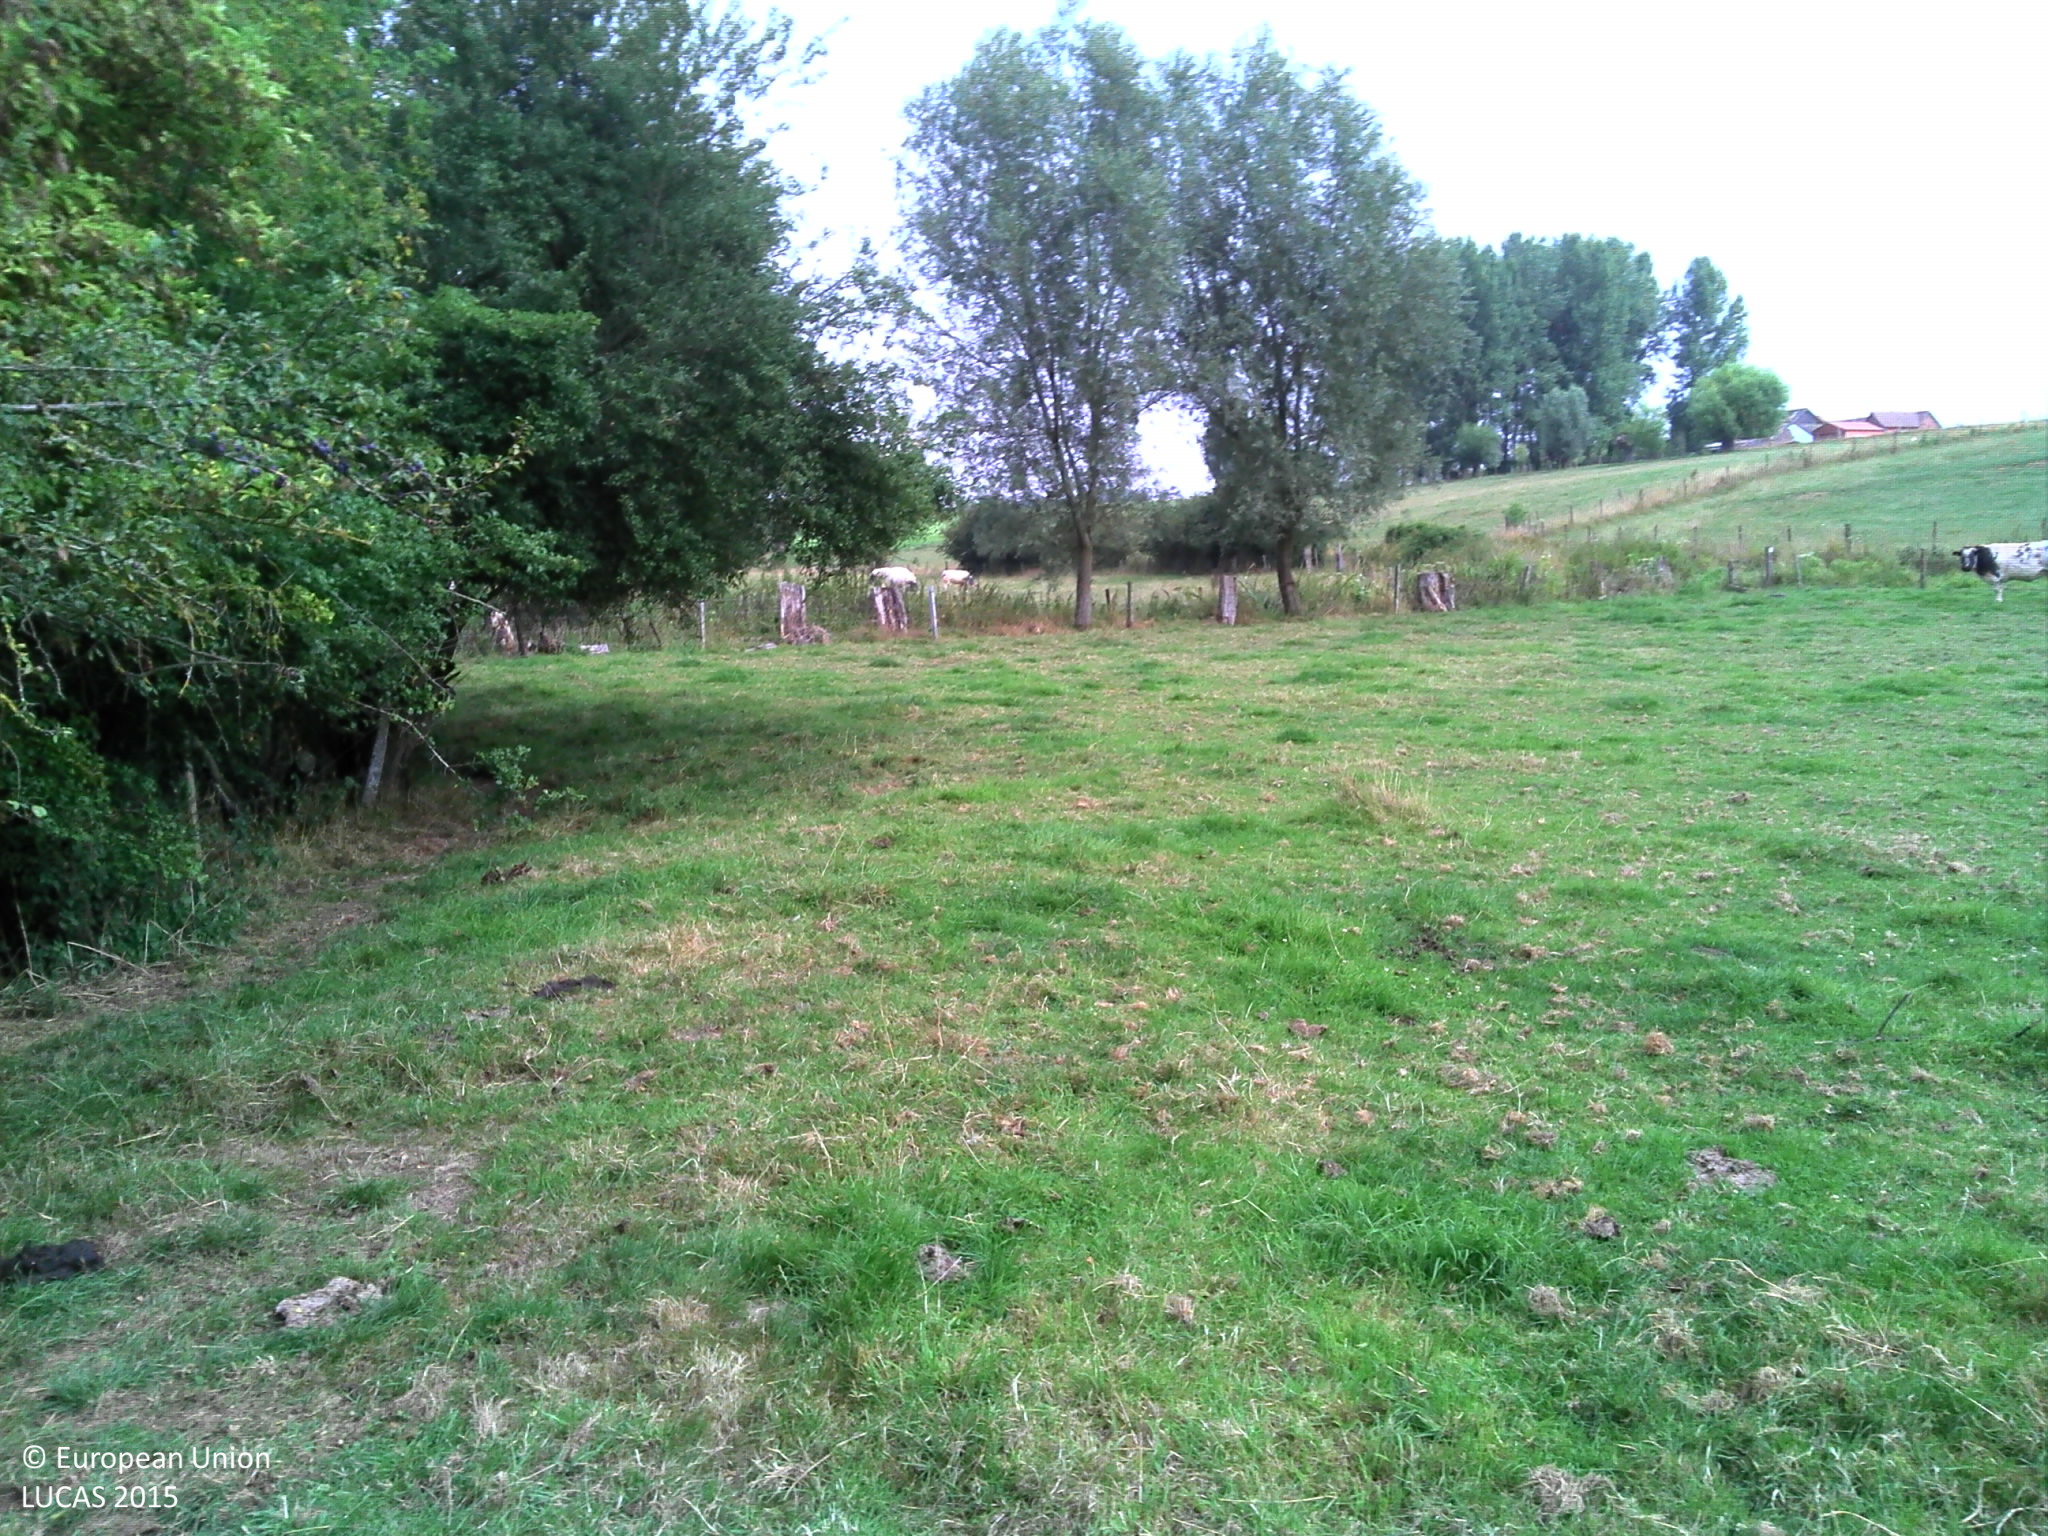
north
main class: Grassland
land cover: Grassland without tree/shrub cover
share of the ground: > 75 %
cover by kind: herbaceous plants 100 %
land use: Agriculture (excluding fallow land and kitchen gardens)
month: August
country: BE
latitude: 50.6817
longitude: 3.7803
